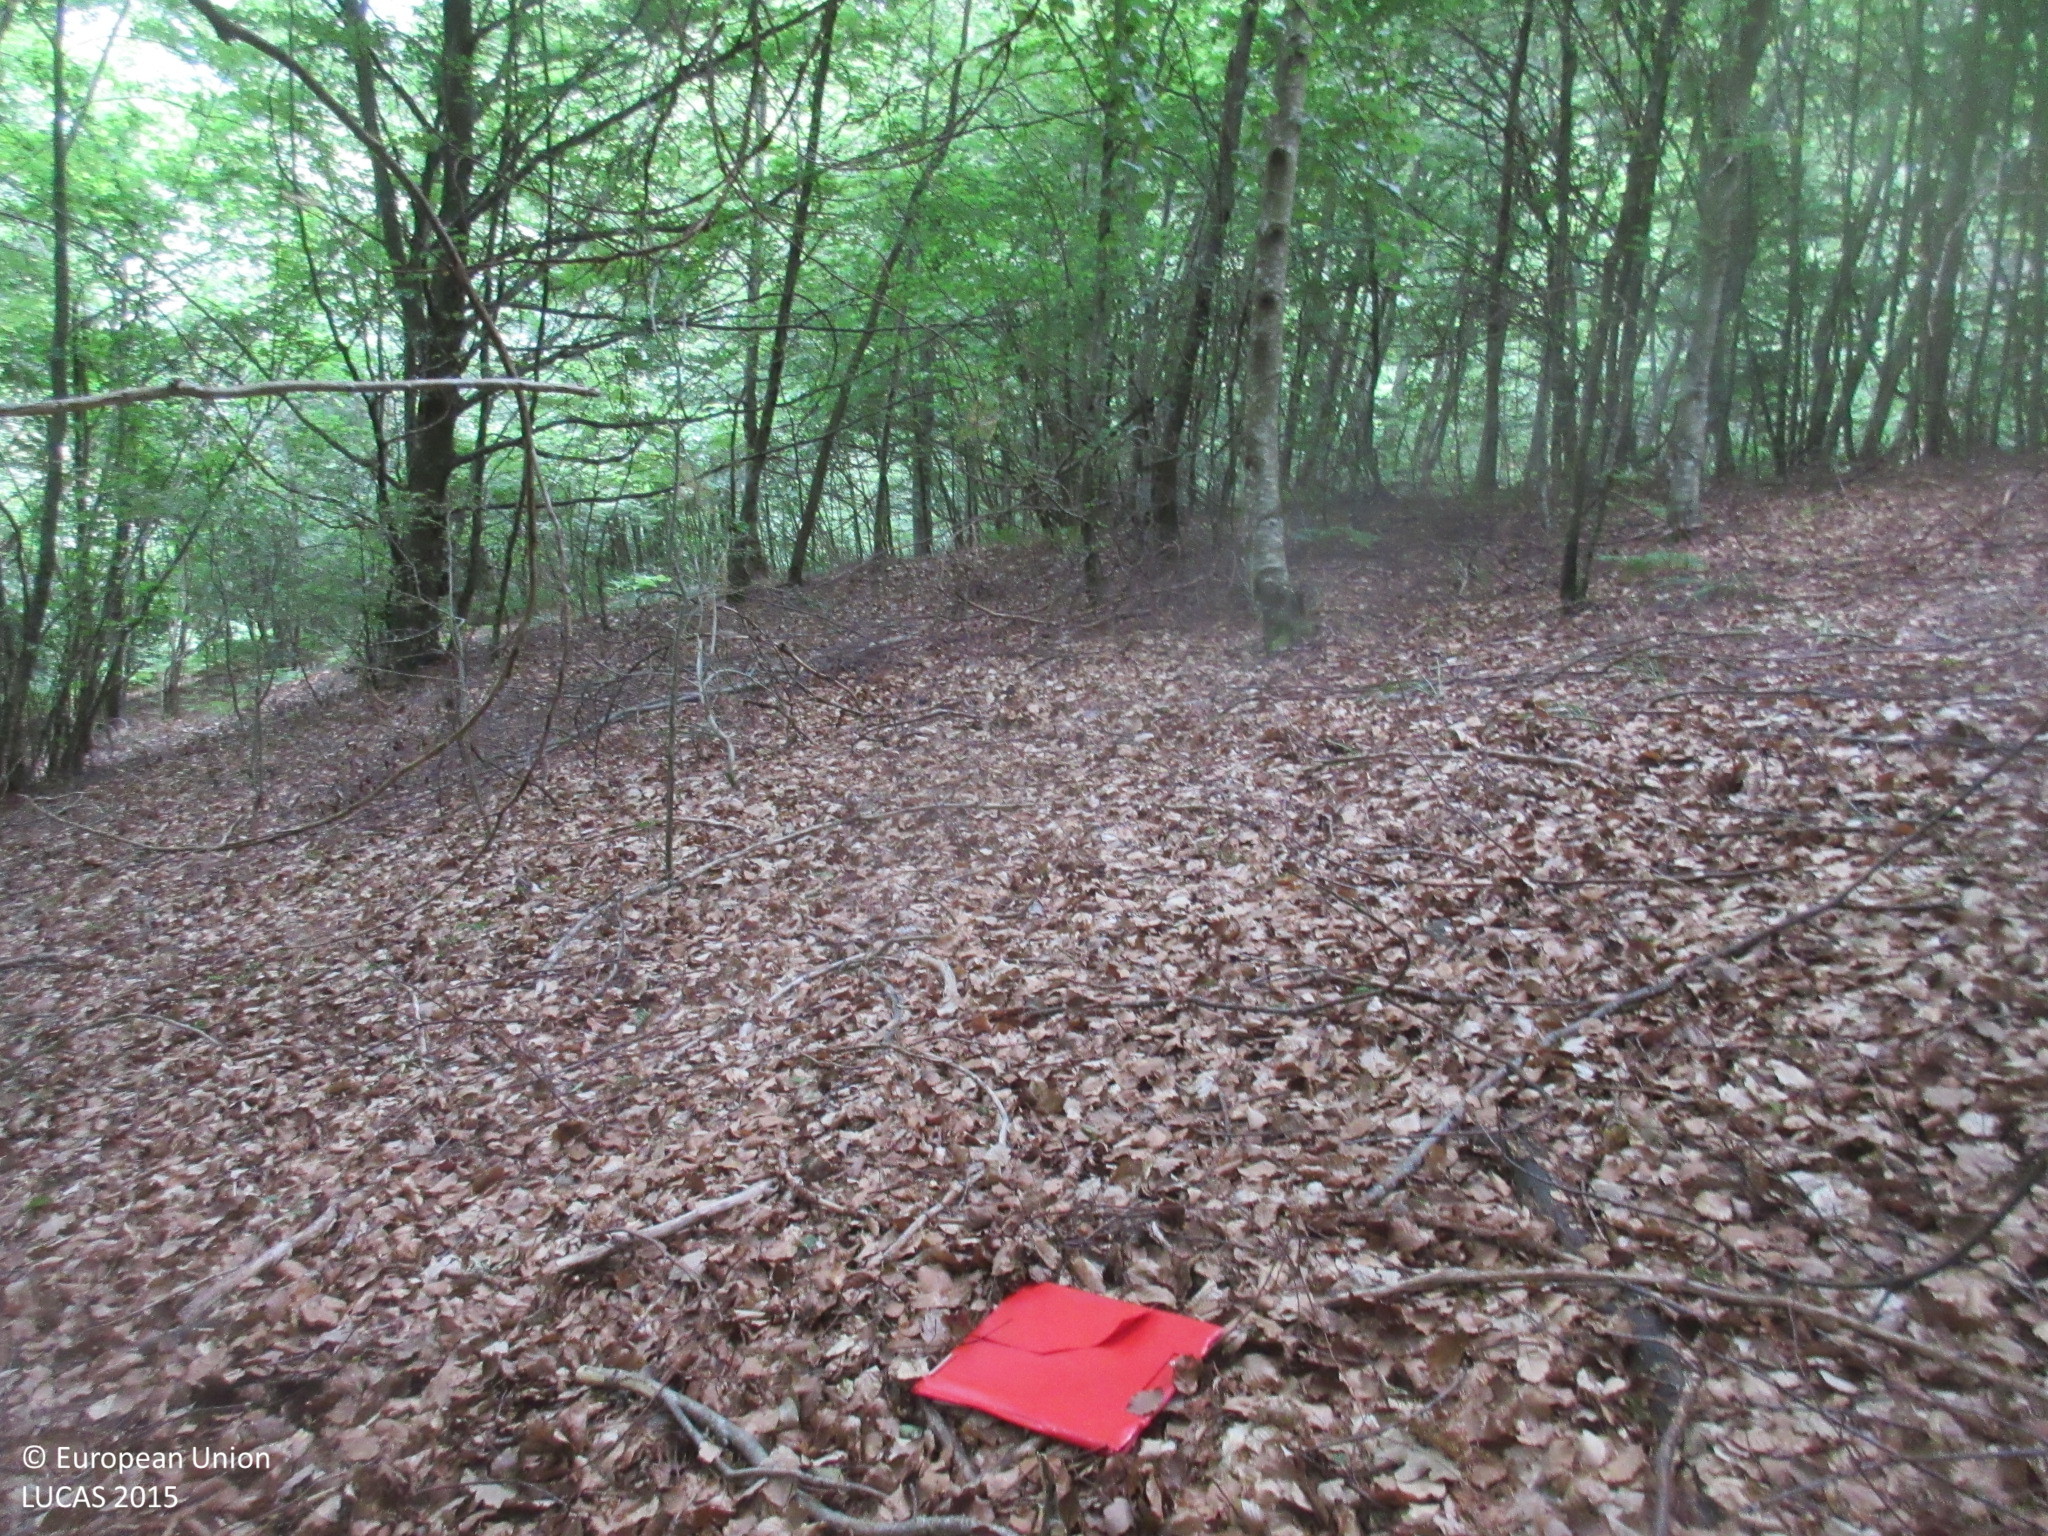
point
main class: Woodland
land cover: Broadleaved woodland
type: beech forest
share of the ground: > 75 %
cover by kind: broadleaved forest trees 100 %
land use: Semi-natural and natural areas not in use
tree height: > 5 m
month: June
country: ES
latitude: 43.0678
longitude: -4.5112
